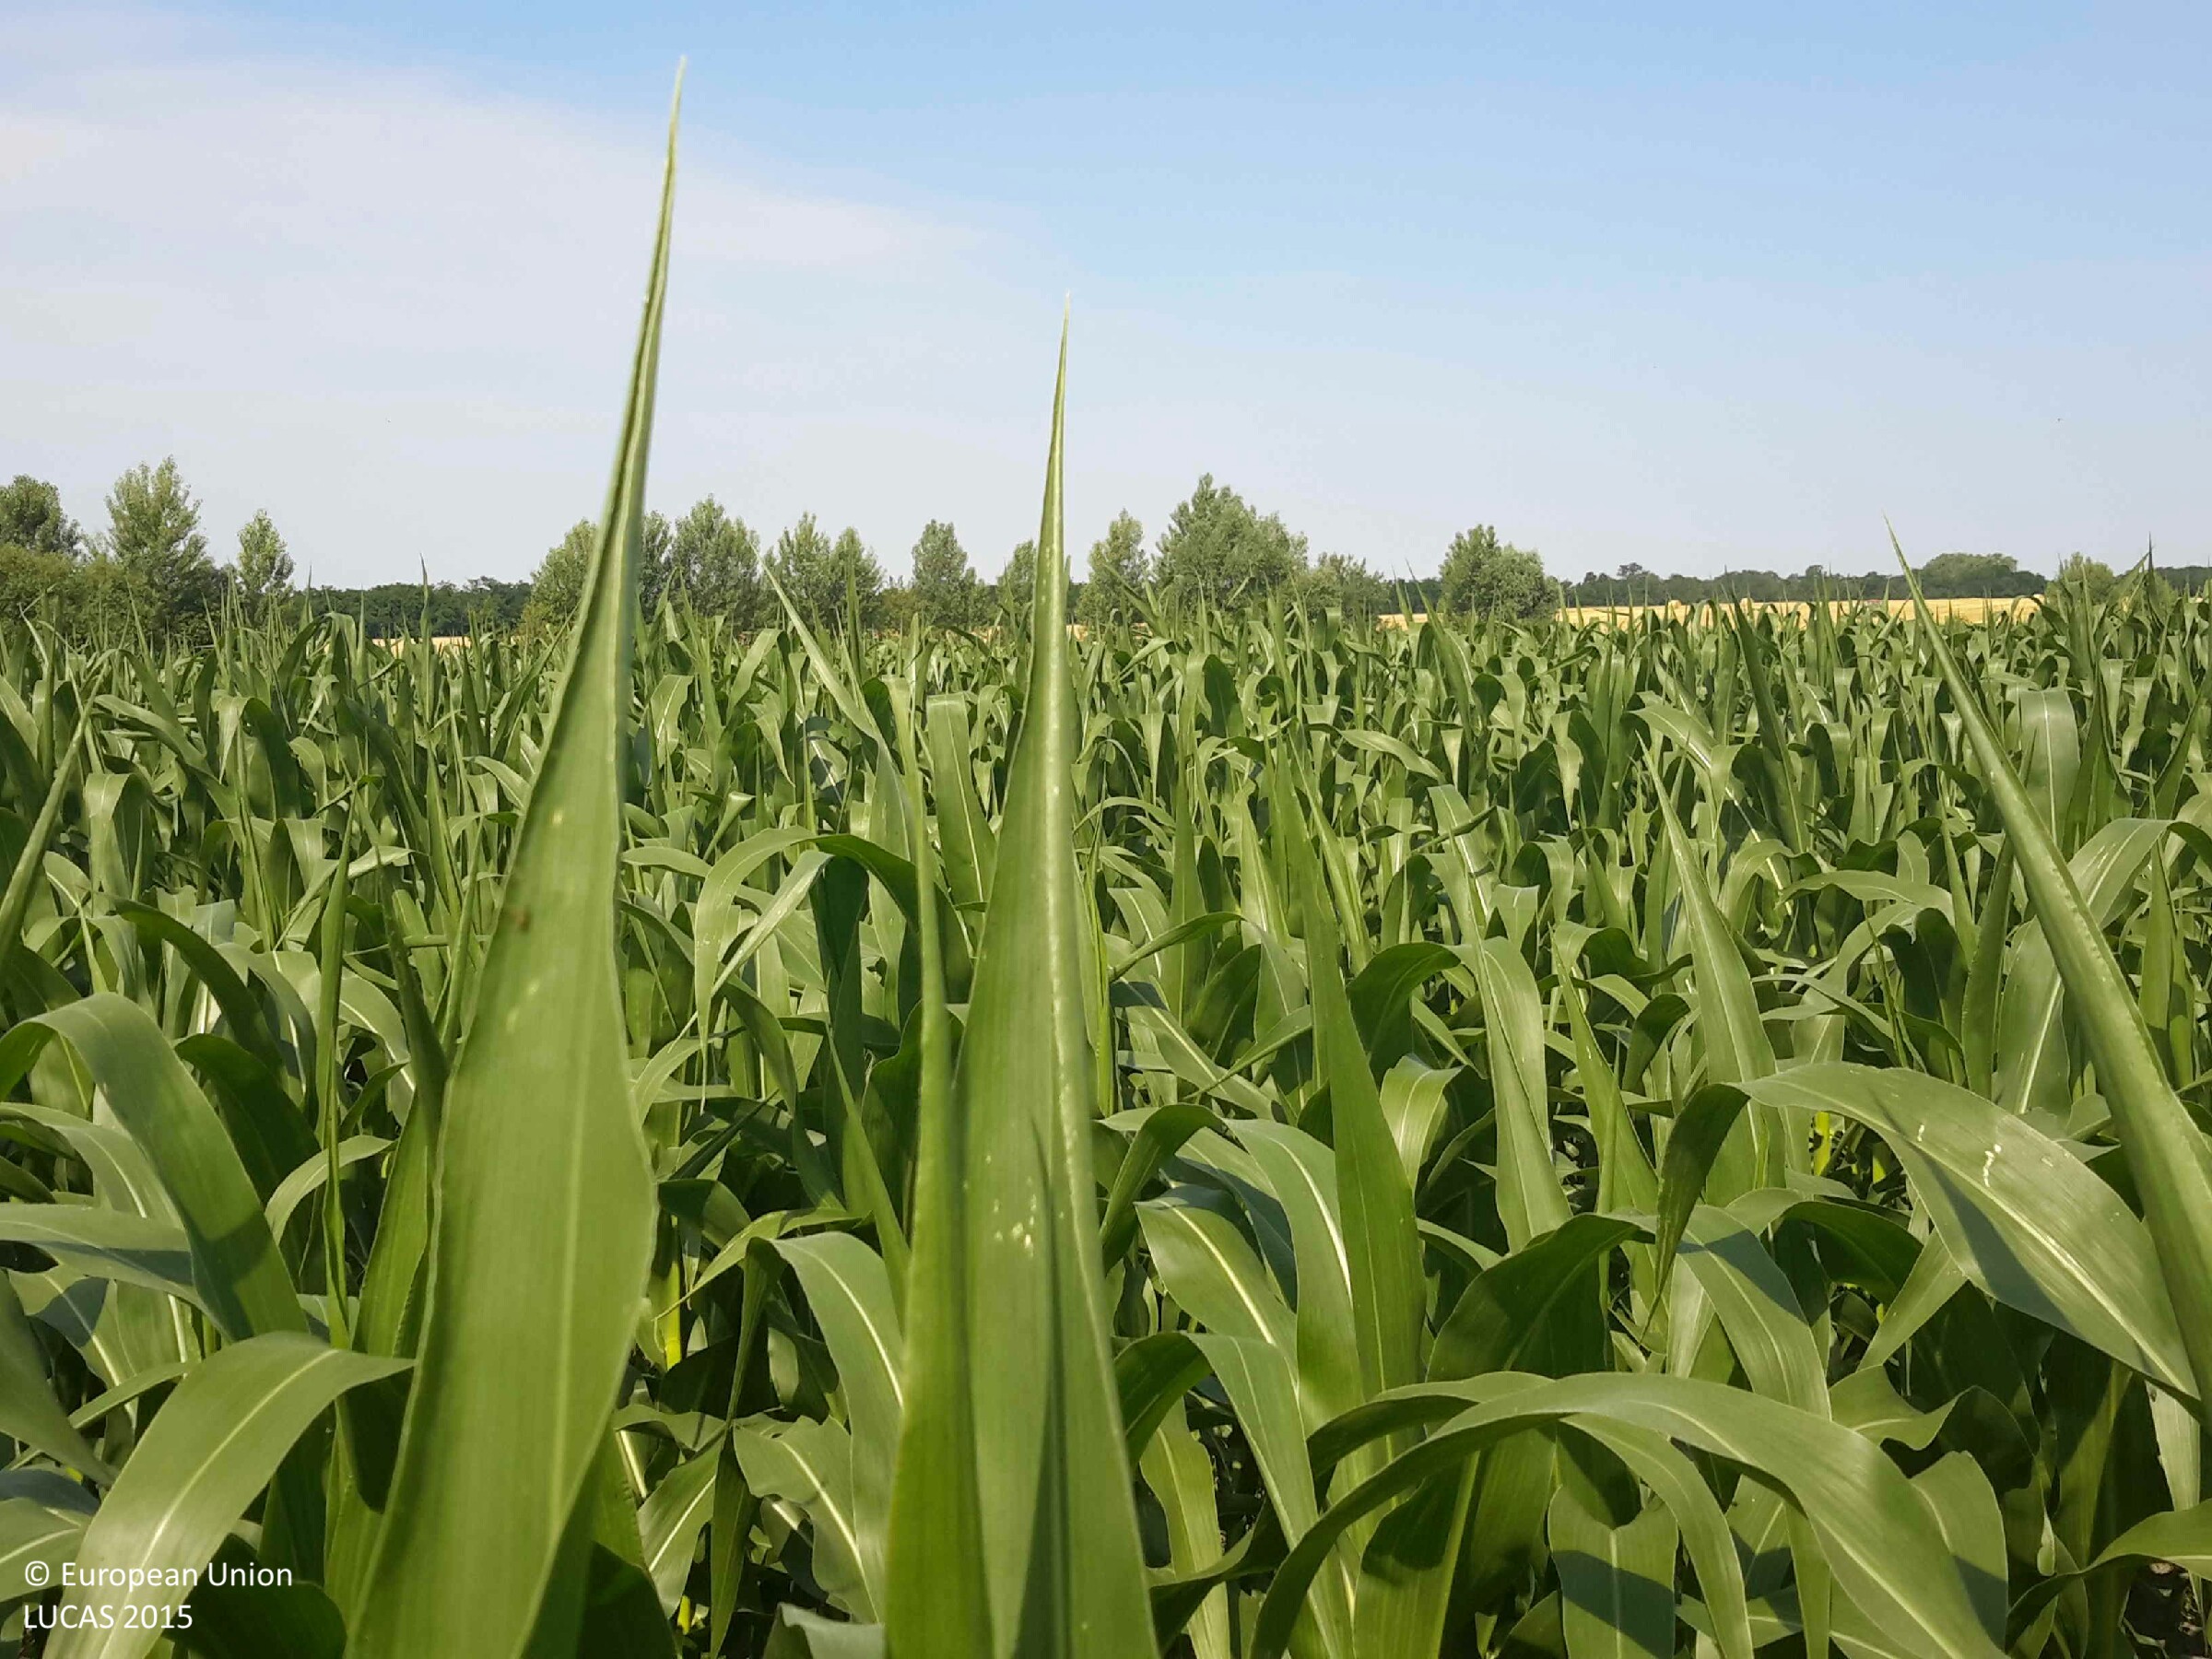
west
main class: Cropland
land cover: Maize
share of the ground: > 75 %
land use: Agriculture (excluding fallow land and kitchen gardens)
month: July
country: HU
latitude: 47.3703
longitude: 17.5164
